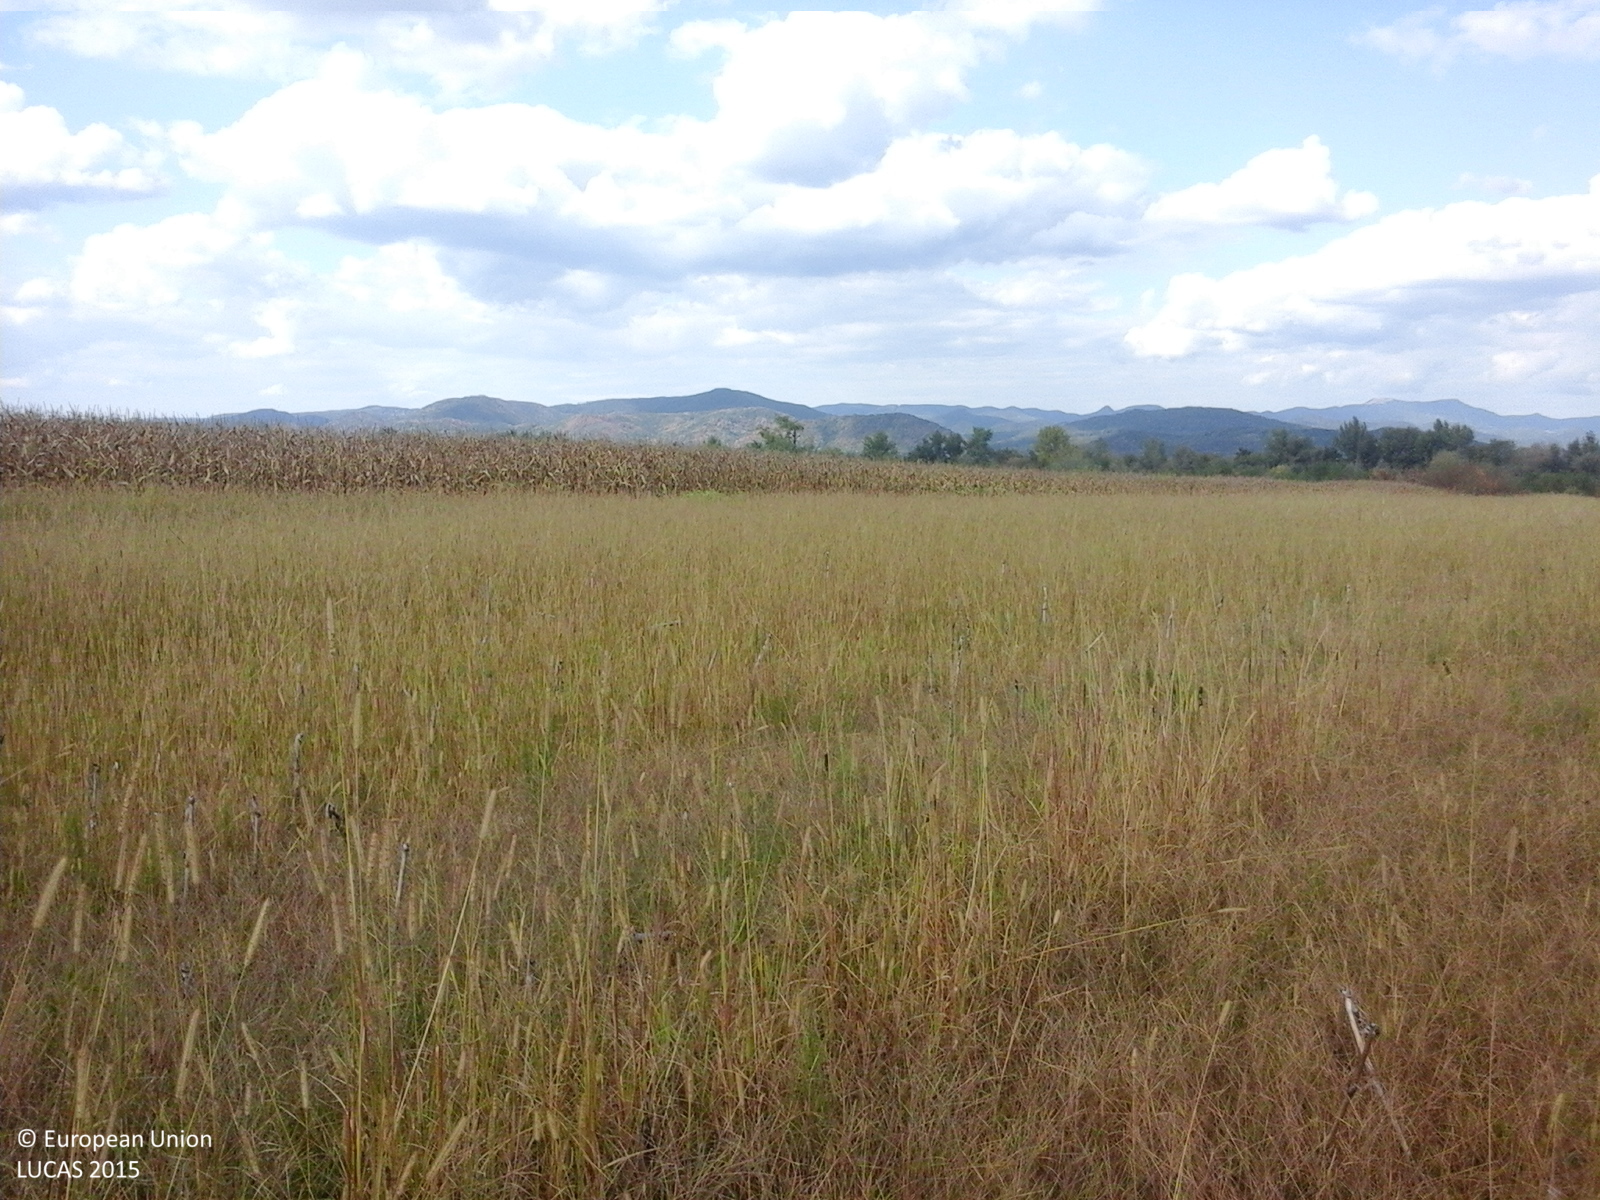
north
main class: Grassland
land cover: Spontaneously vegetated surfaces
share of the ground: > 75 %
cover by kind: herbaceous plants 100 %
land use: Fallow land
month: September
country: RO
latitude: 47.6320
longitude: 23.4487
